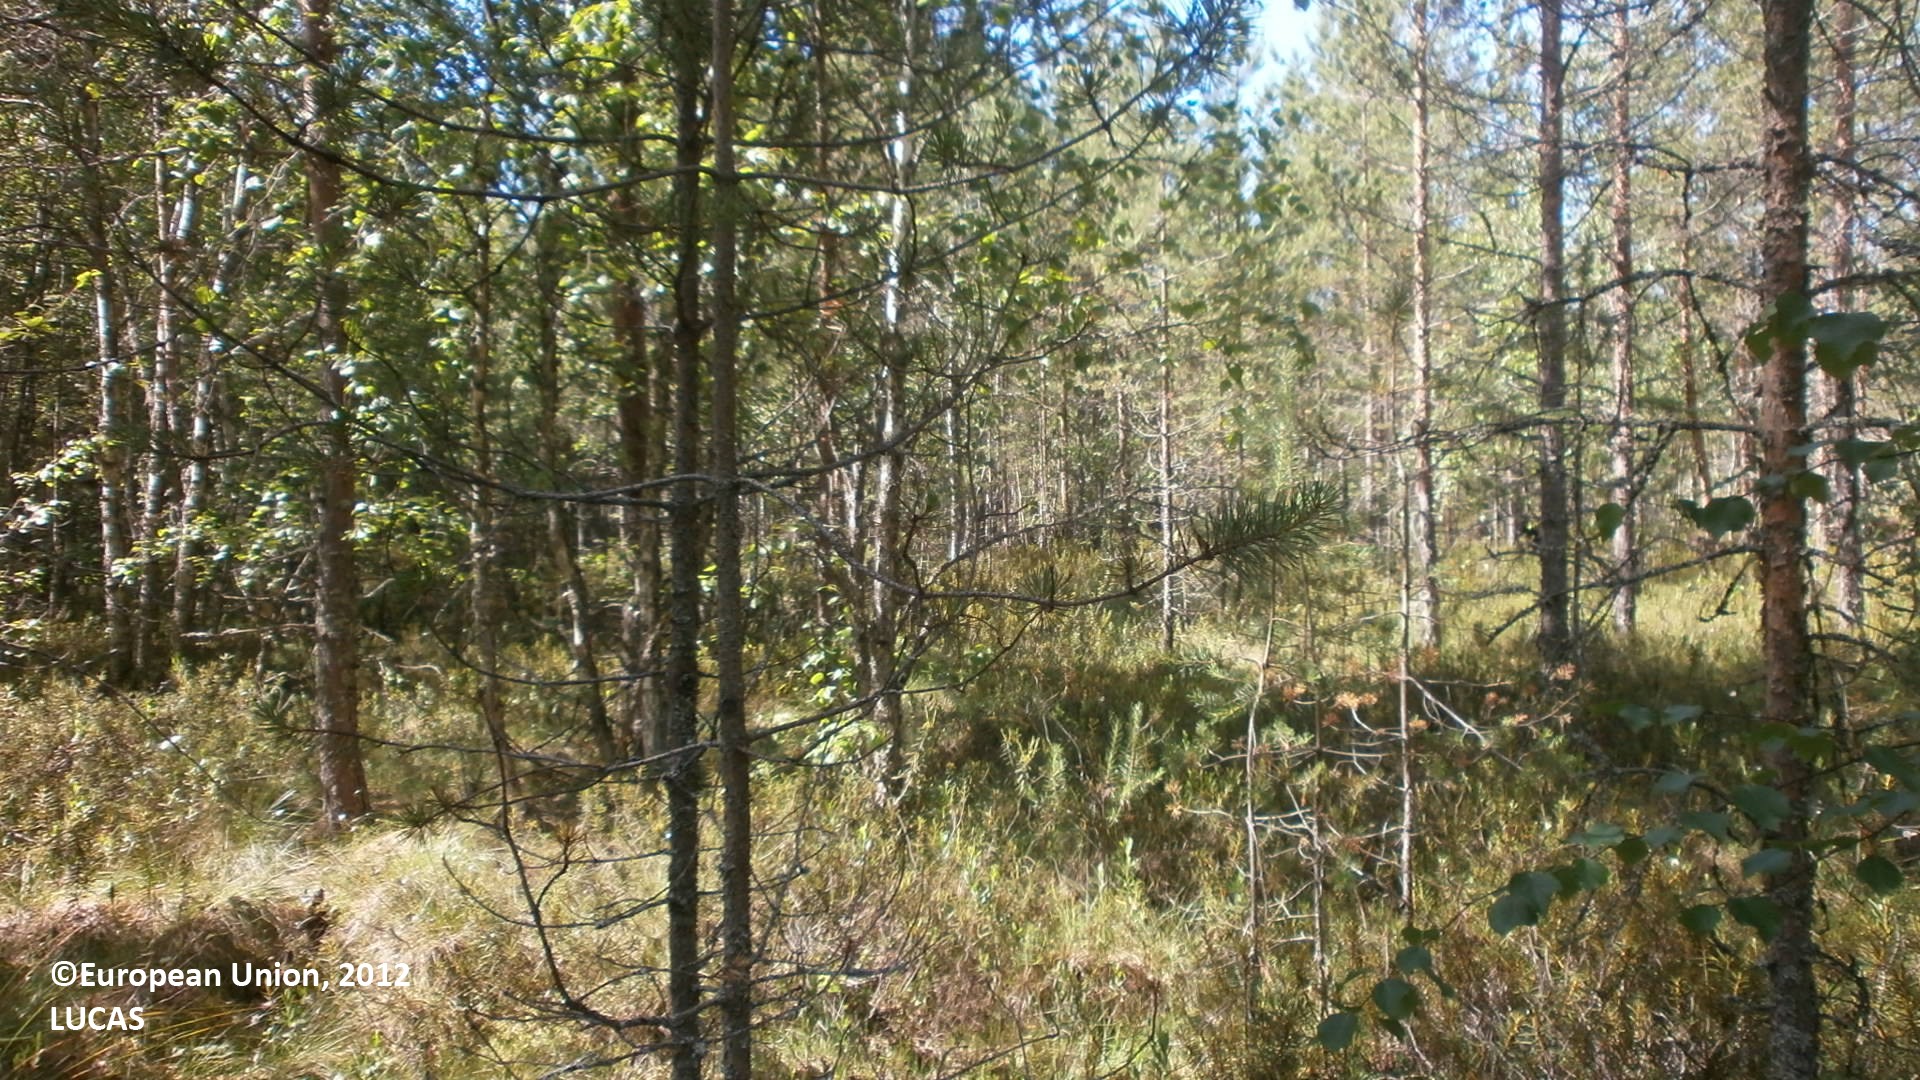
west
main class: Woodland
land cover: Pine dominated mixed woodland
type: mire and swamp forests
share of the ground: 50 - 75 %
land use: Forestry
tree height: > 5 m
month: July
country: FI
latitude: 64.2738
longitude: 24.1681
